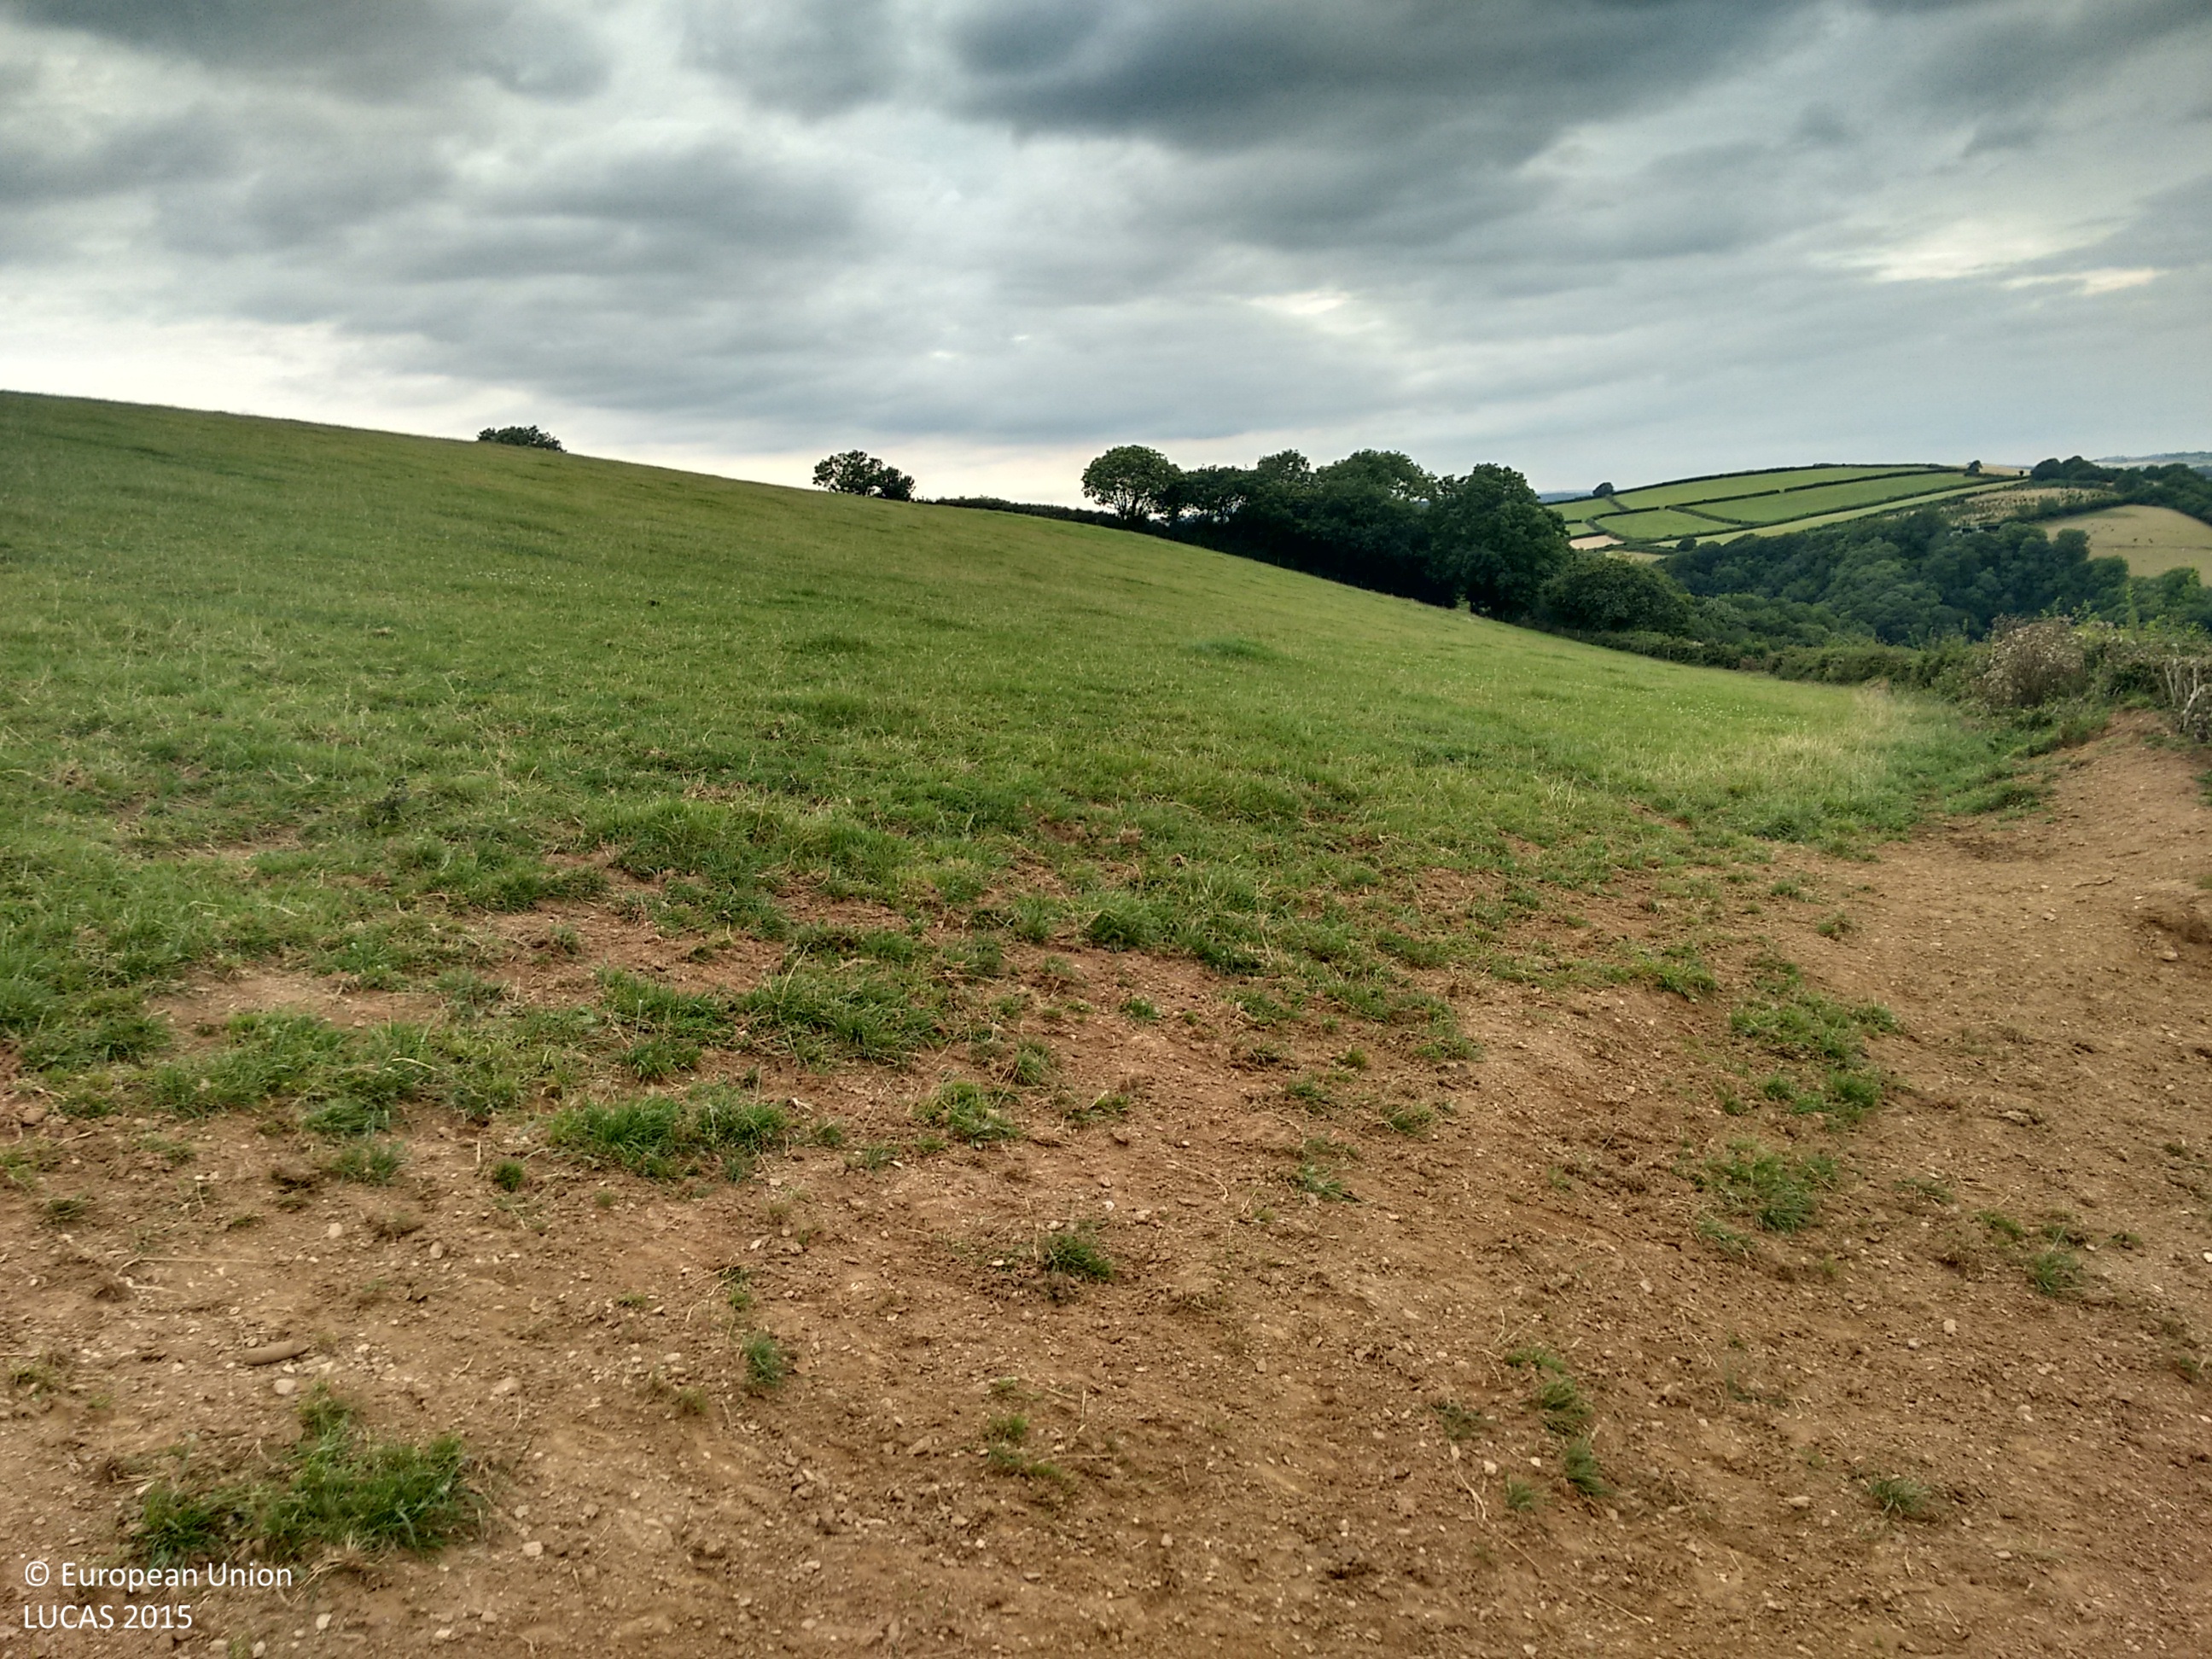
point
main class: Grassland
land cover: Grassland without tree/shrub cover
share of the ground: > 75 %
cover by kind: herbaceous plants 100 %
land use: Agriculture (excluding fallow land and kitchen gardens)
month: August
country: GB
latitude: 50.4131
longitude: -4.2702
